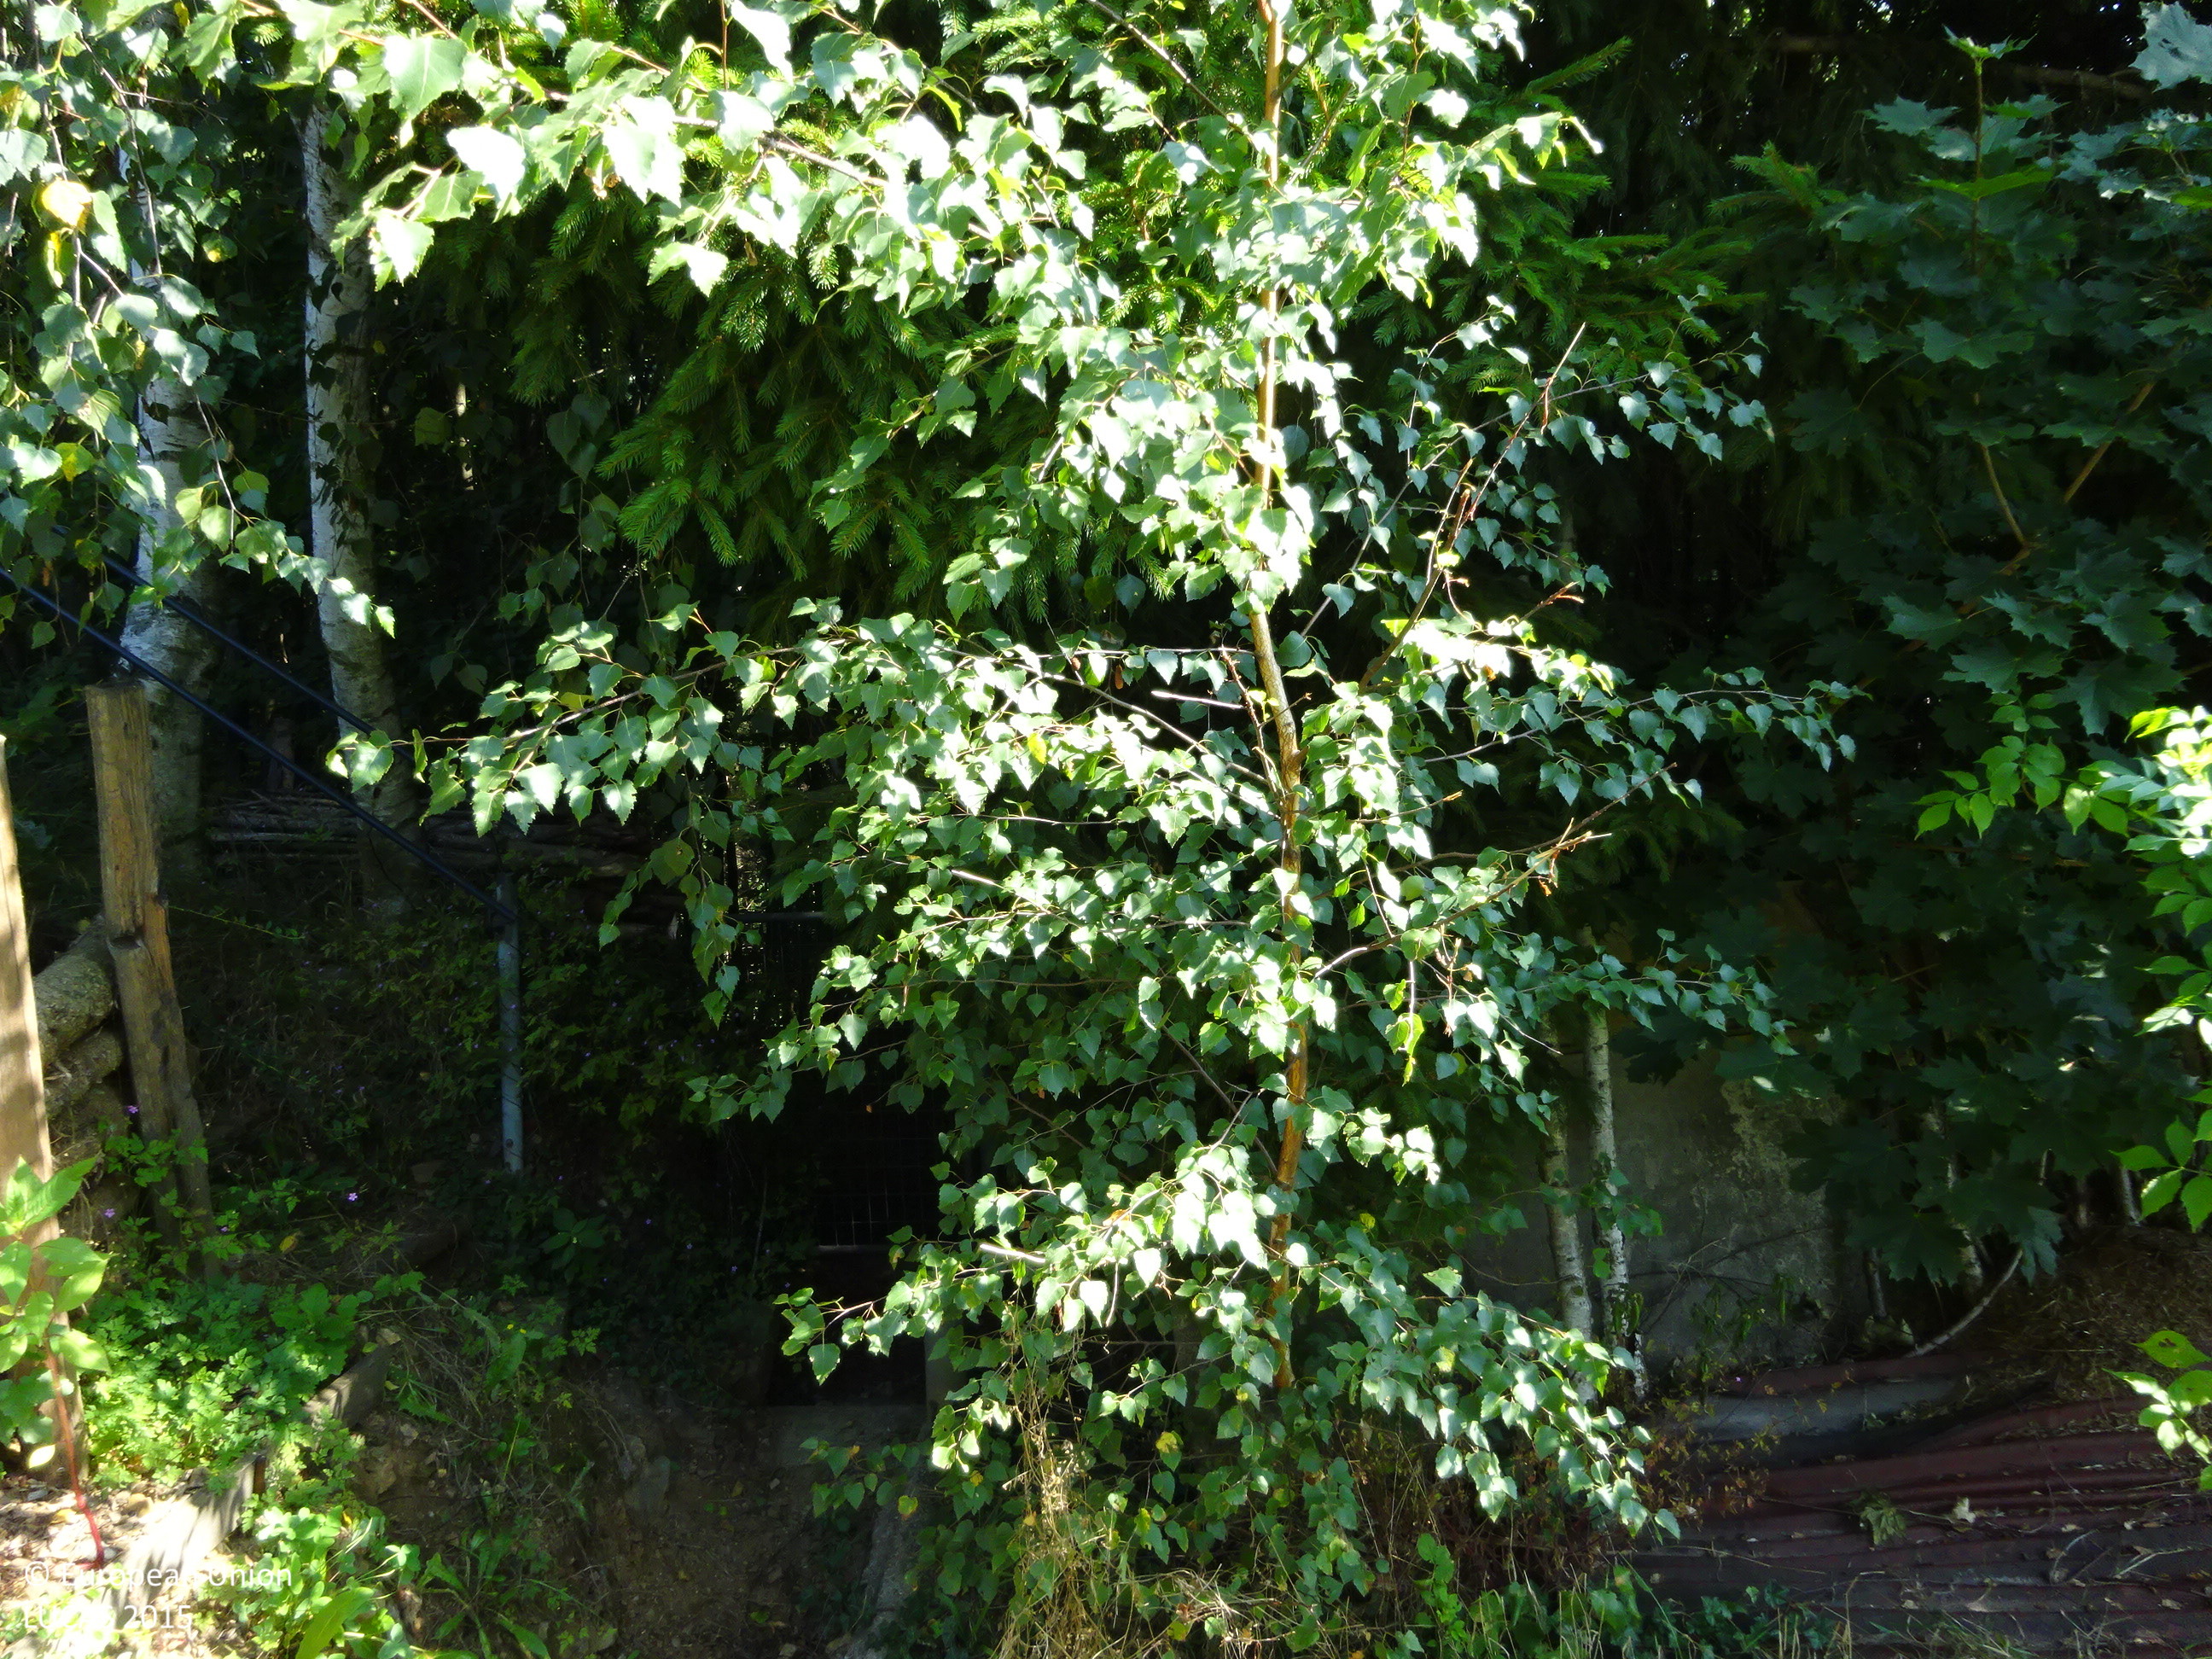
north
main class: Woodland
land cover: Broadleaved woodland
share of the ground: 25 - 50 %
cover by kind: herbaceous plants 55 %, broadleaved forest trees 25 %, unconsolidated bare surface 20 %
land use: Residential
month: August
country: AT
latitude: 47.3937
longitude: 15.9770
